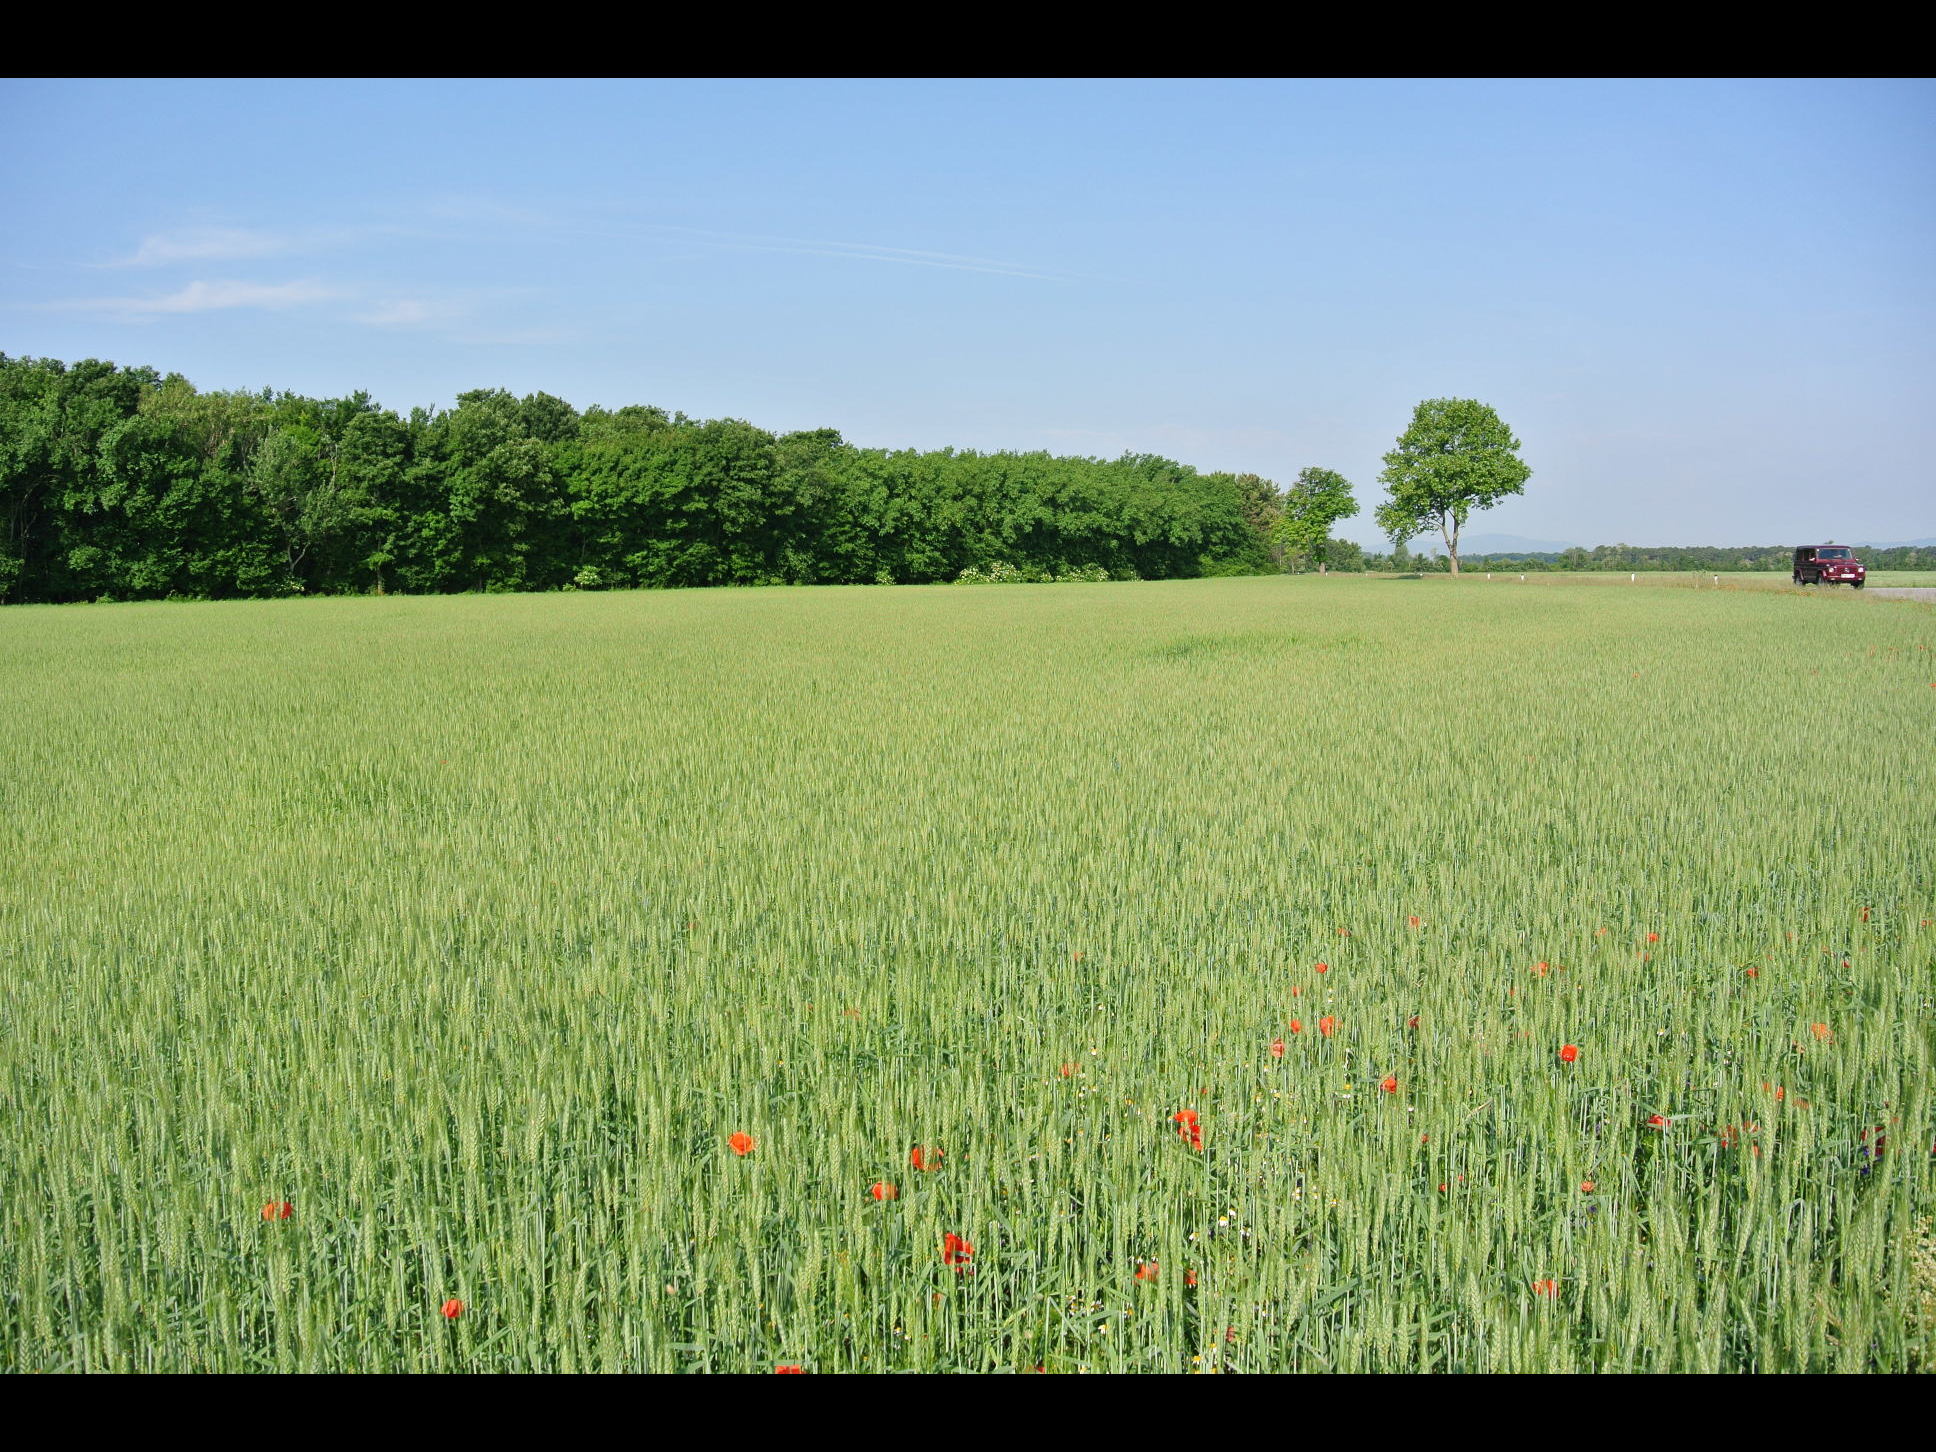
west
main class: Cropland
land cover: Common wheat
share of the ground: > 75 %
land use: Agriculture (excluding fallow land and kitchen gardens)
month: May
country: AT
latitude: 47.9595
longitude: 16.5001
